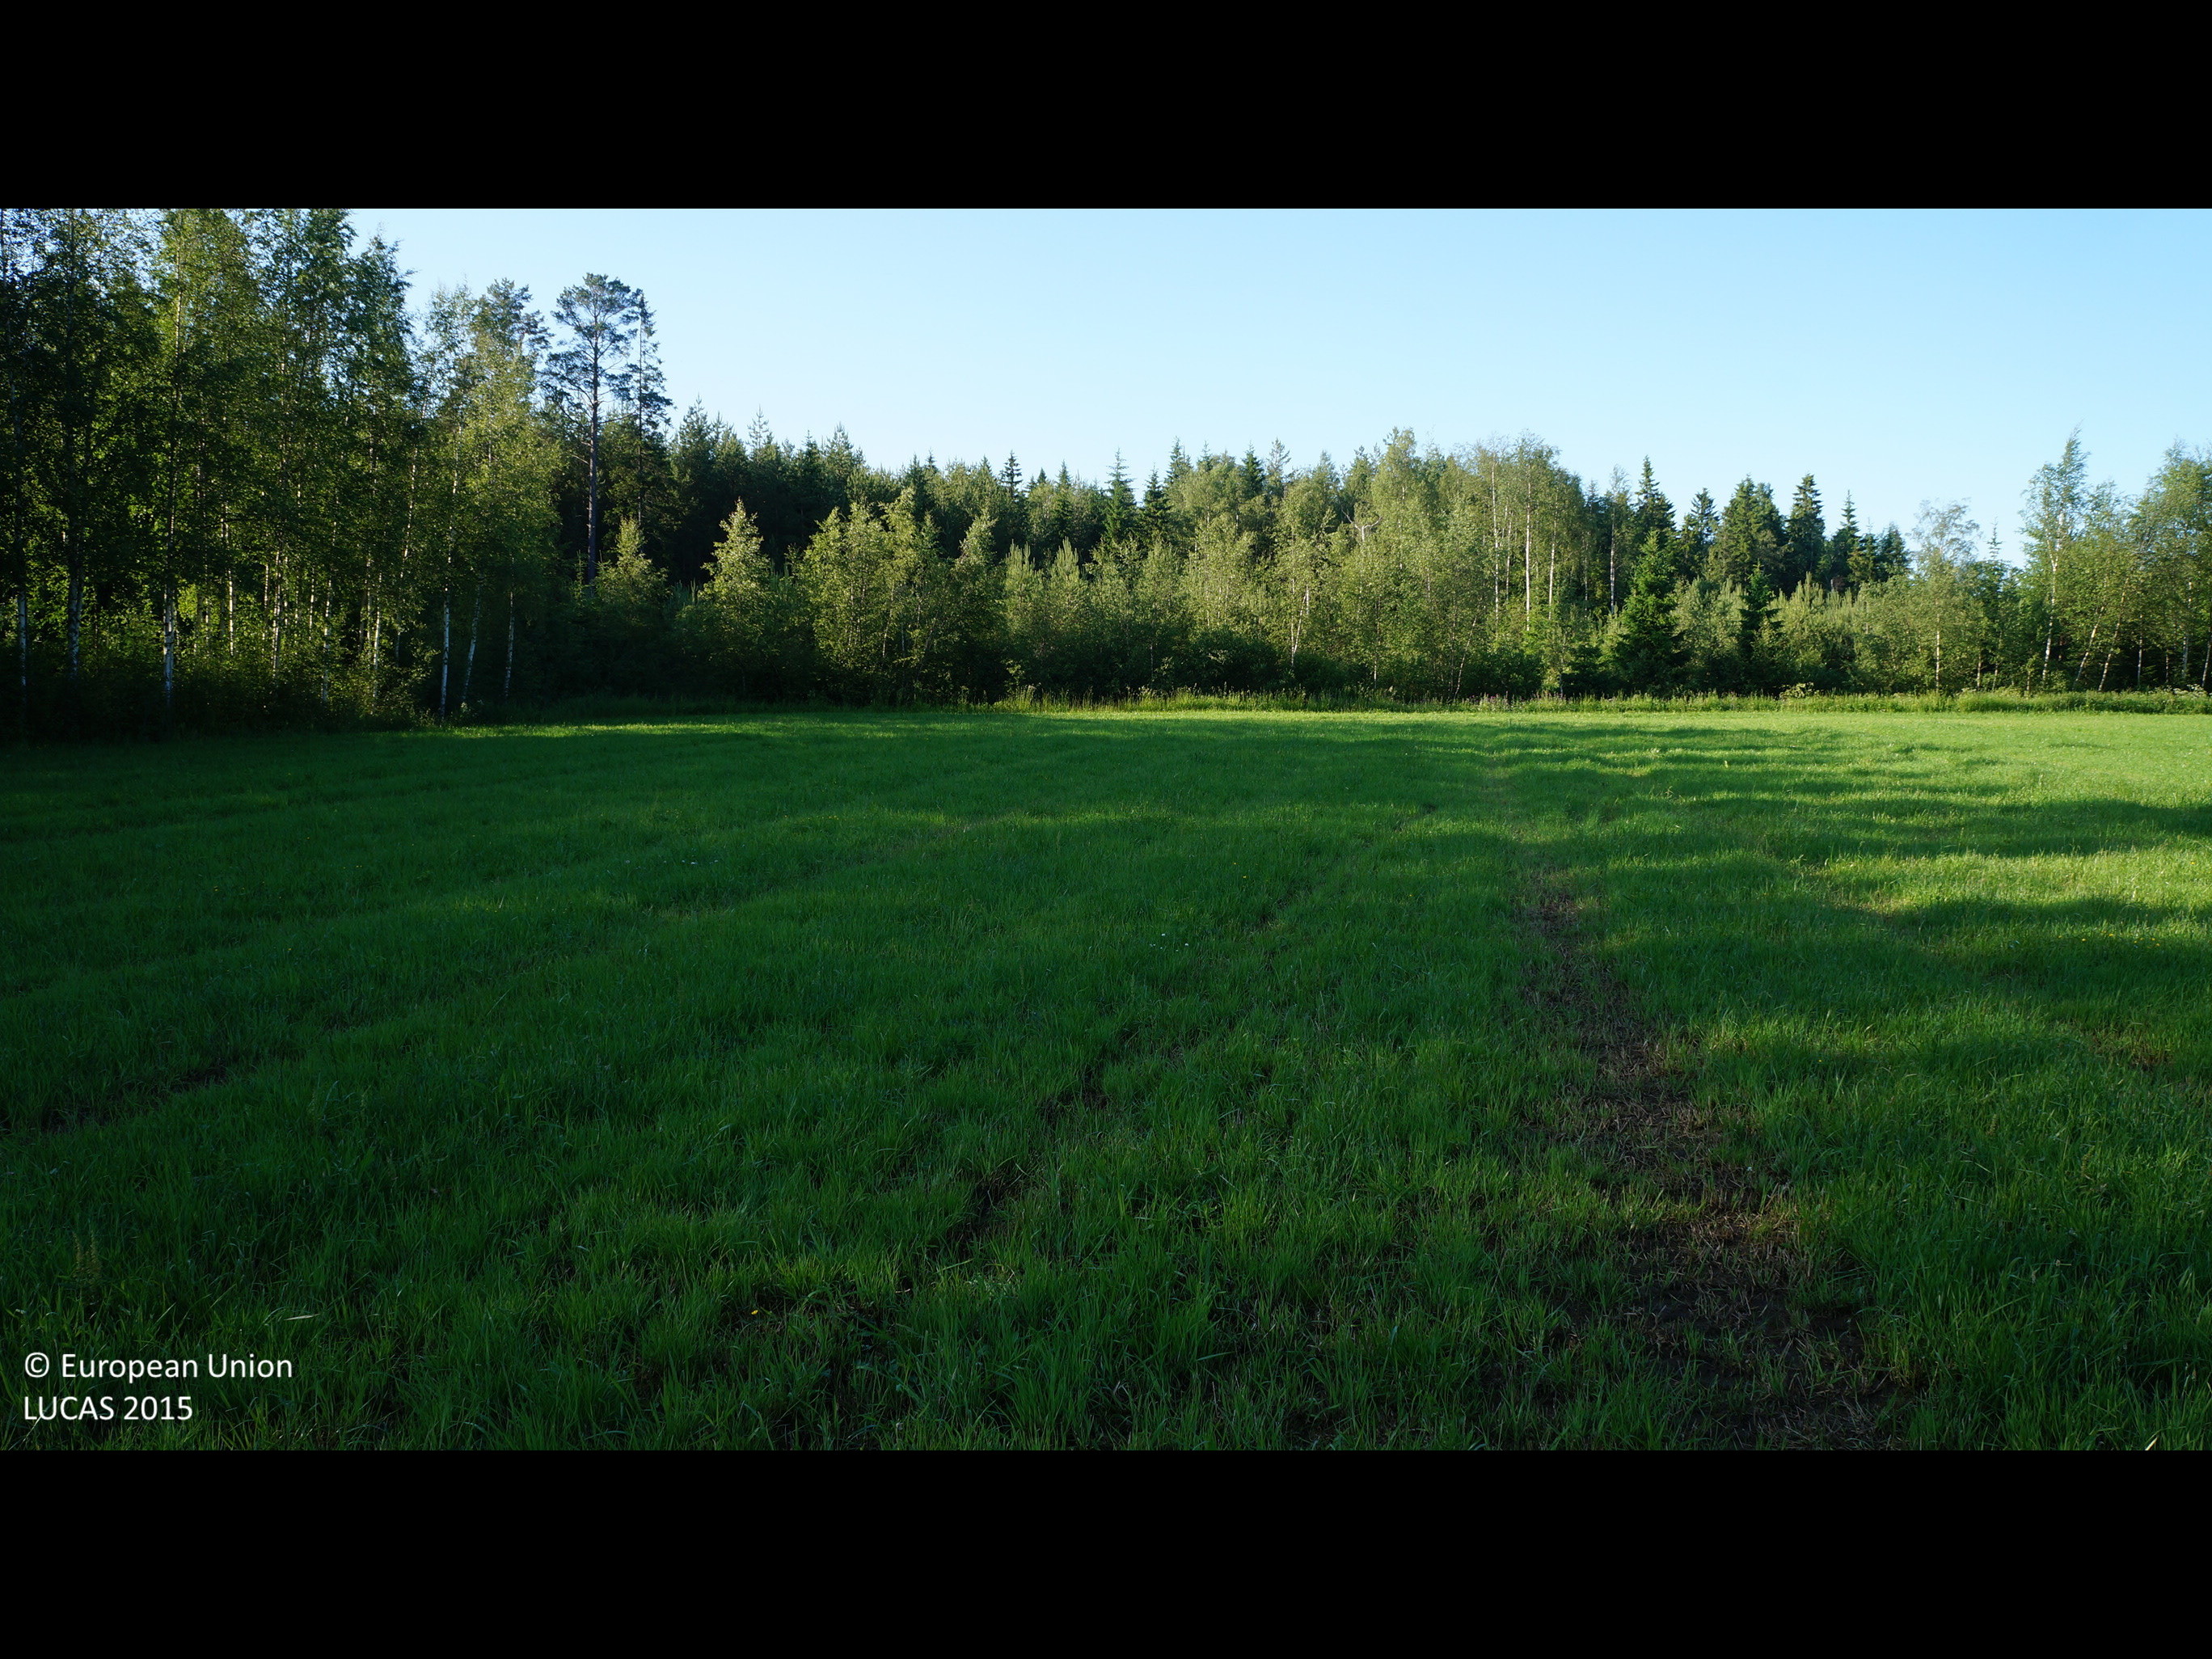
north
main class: Cropland
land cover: Temporary grasslands
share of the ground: 50 - 75 %
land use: Agriculture (excluding fallow land and kitchen gardens)
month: July
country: FI
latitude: 63.6511
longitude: 22.8745
